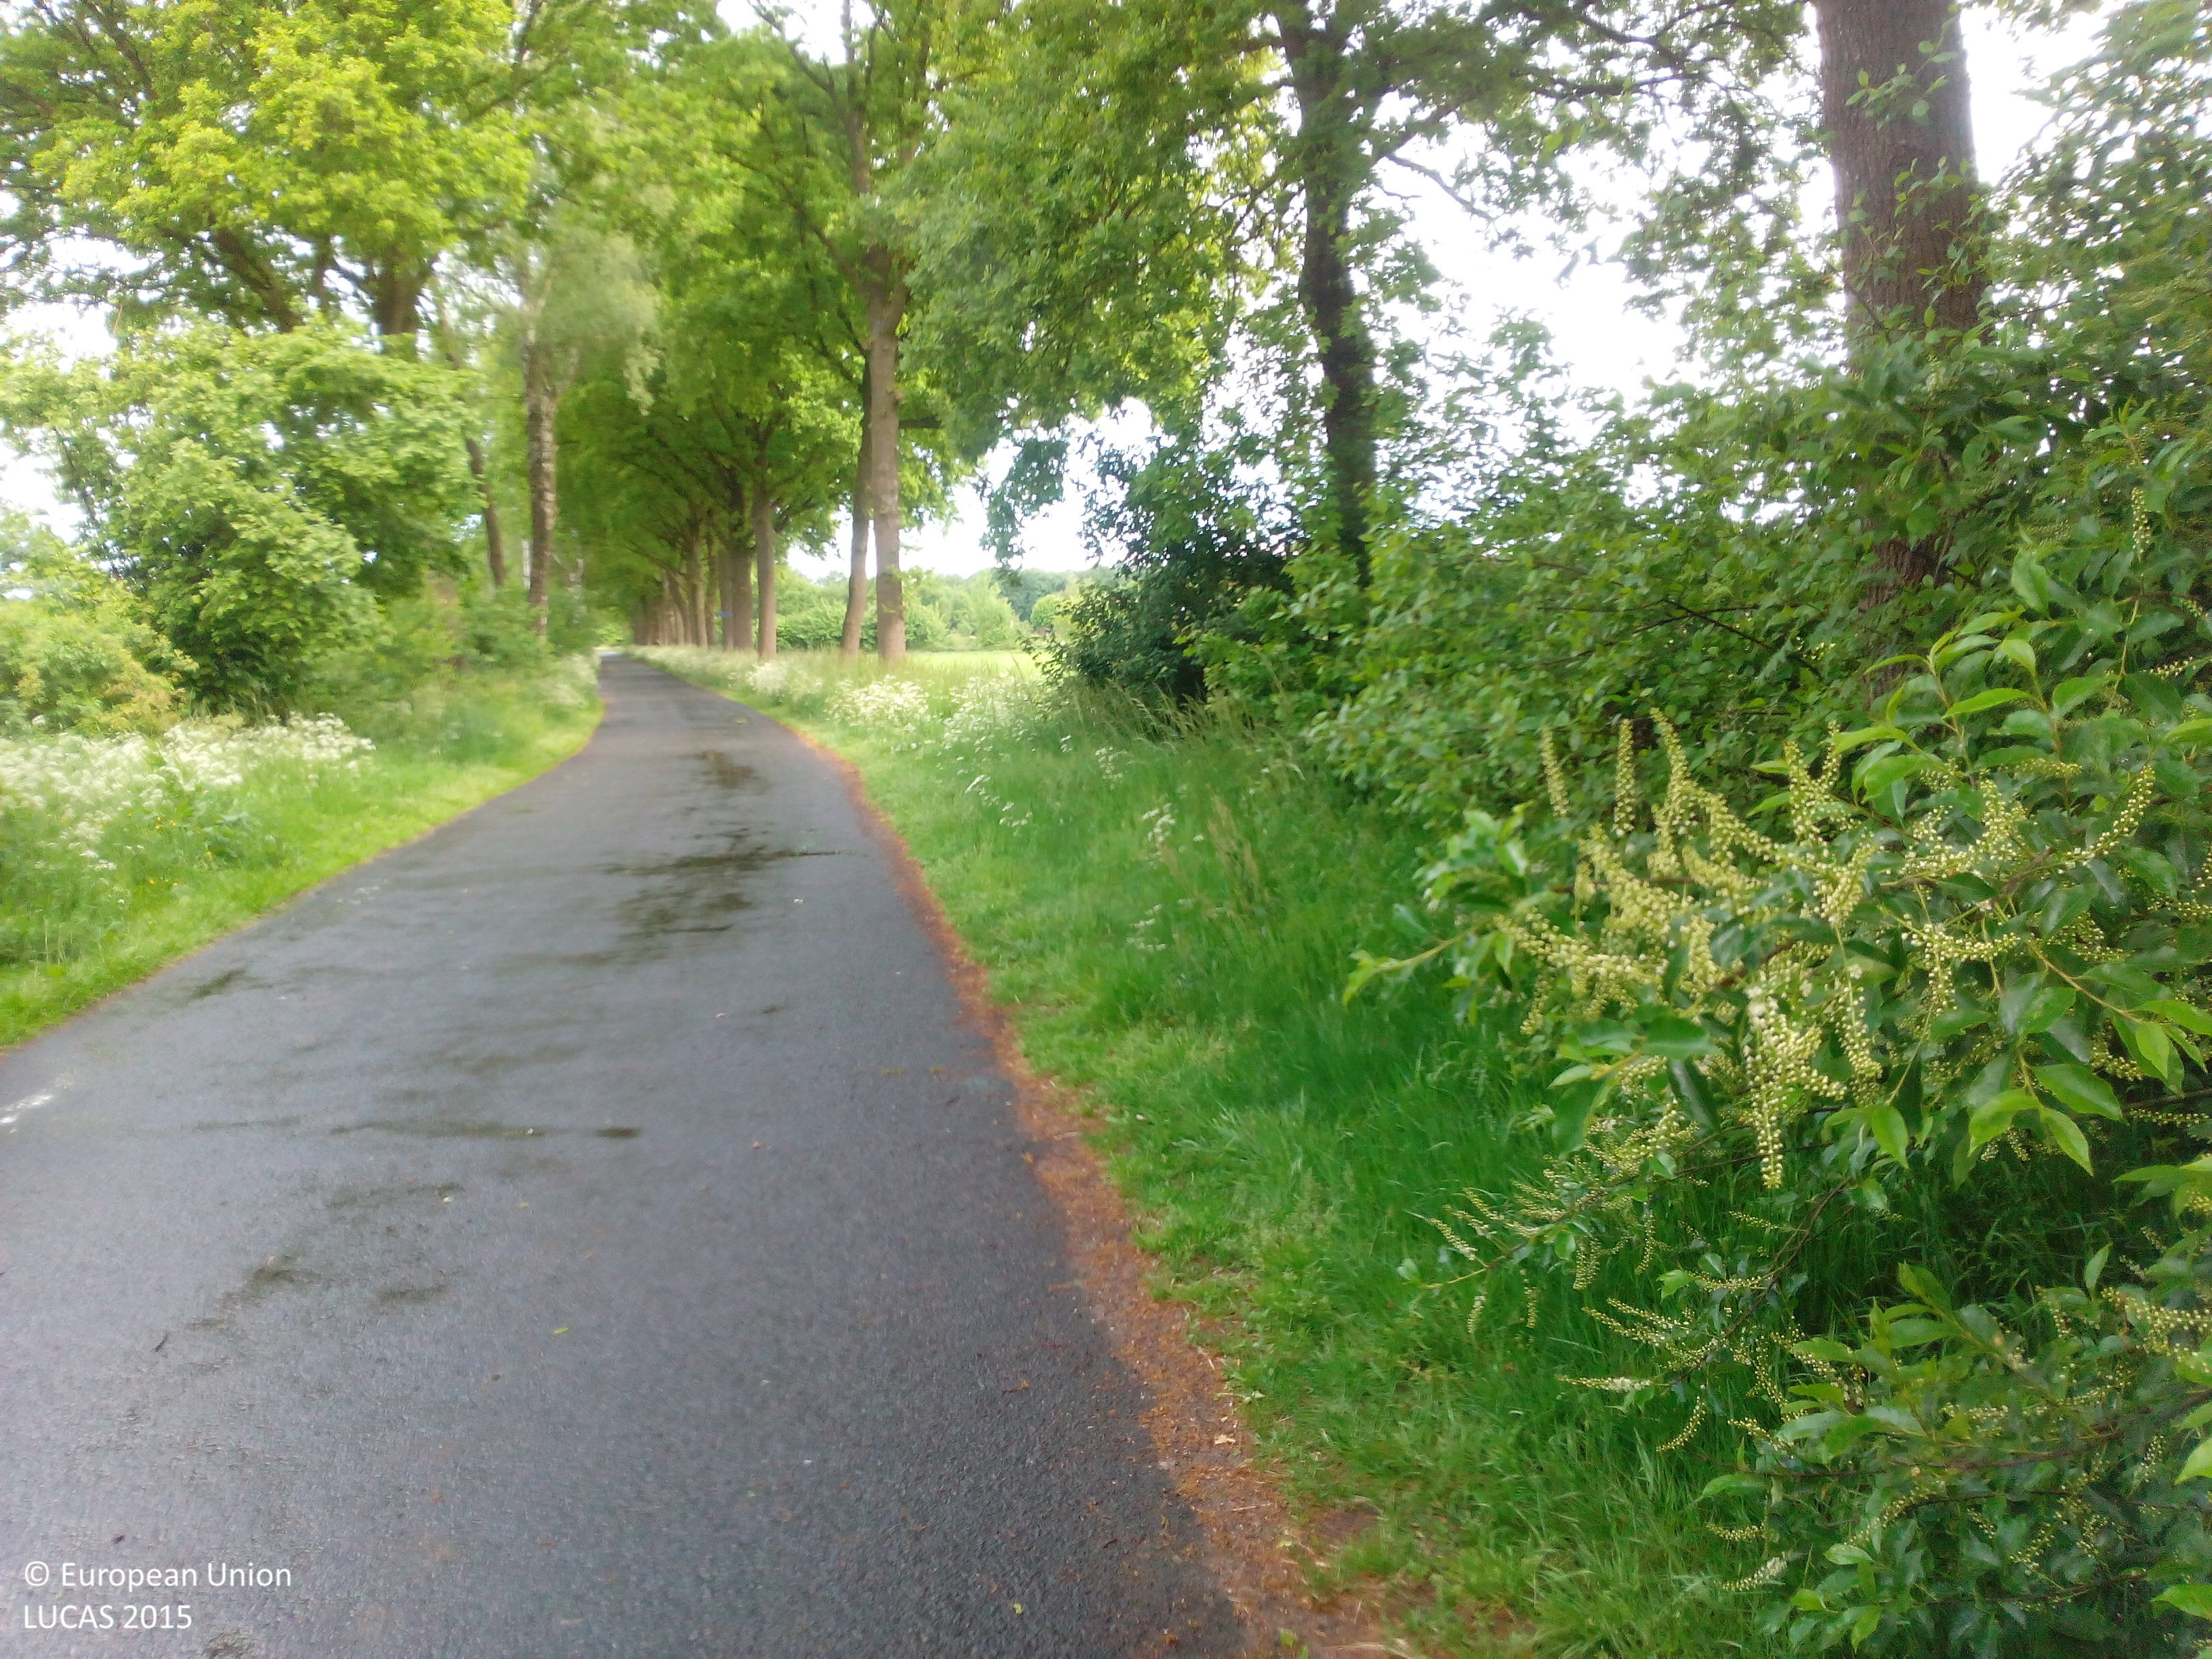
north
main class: Woodland
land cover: Broadleaved woodland
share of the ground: > 75 %
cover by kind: broadleaved forest trees 90 %, shrubs 10 %
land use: Road transport
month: May
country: NL
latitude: 52.2827
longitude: 6.2616
